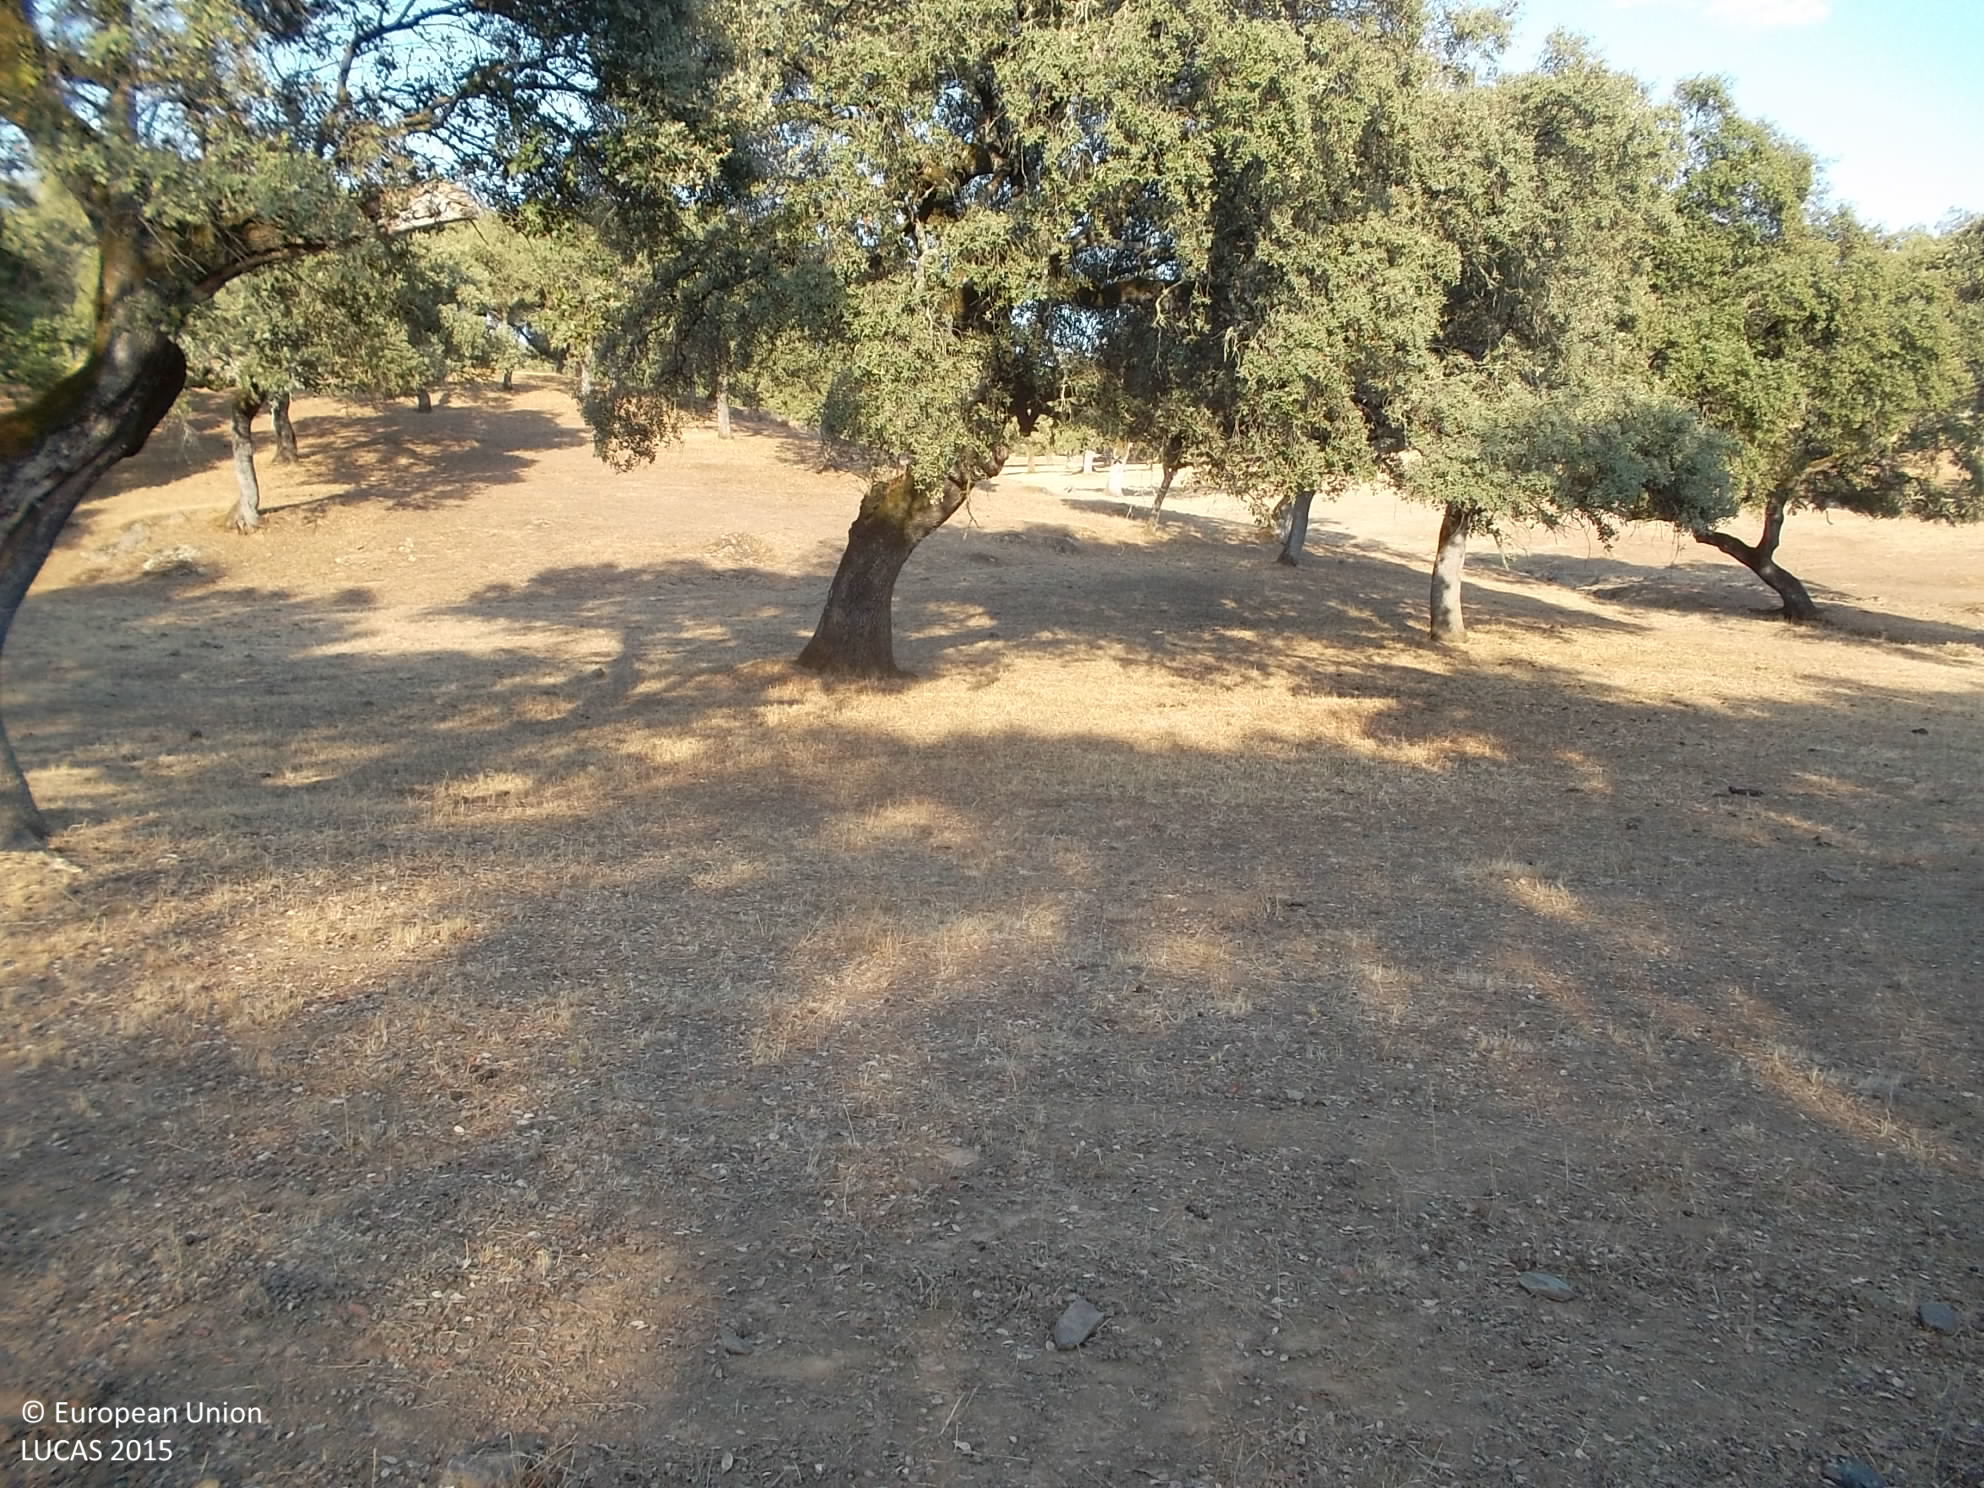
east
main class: Woodland
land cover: Broadleaved woodland
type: broadleaved evergreen forest
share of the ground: 10 - 25 %
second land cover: Grassland without tree/shrub cover
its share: > 75 %
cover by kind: herbaceous plants 80 %, broadleaved forest trees 20 %
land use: Forestry
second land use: Agriculture (excluding fallow land and kitchen gardens)
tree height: > 5 m
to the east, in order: Broadleaved woodland; Grassland without tree/shrub cover; Dry stone walls; Rivers and streams; Broadleaved woodland; Grassland with sparse tree/shrub cover; Broadleaved woodland
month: September
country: ES
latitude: 38.0425
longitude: -6.5335
